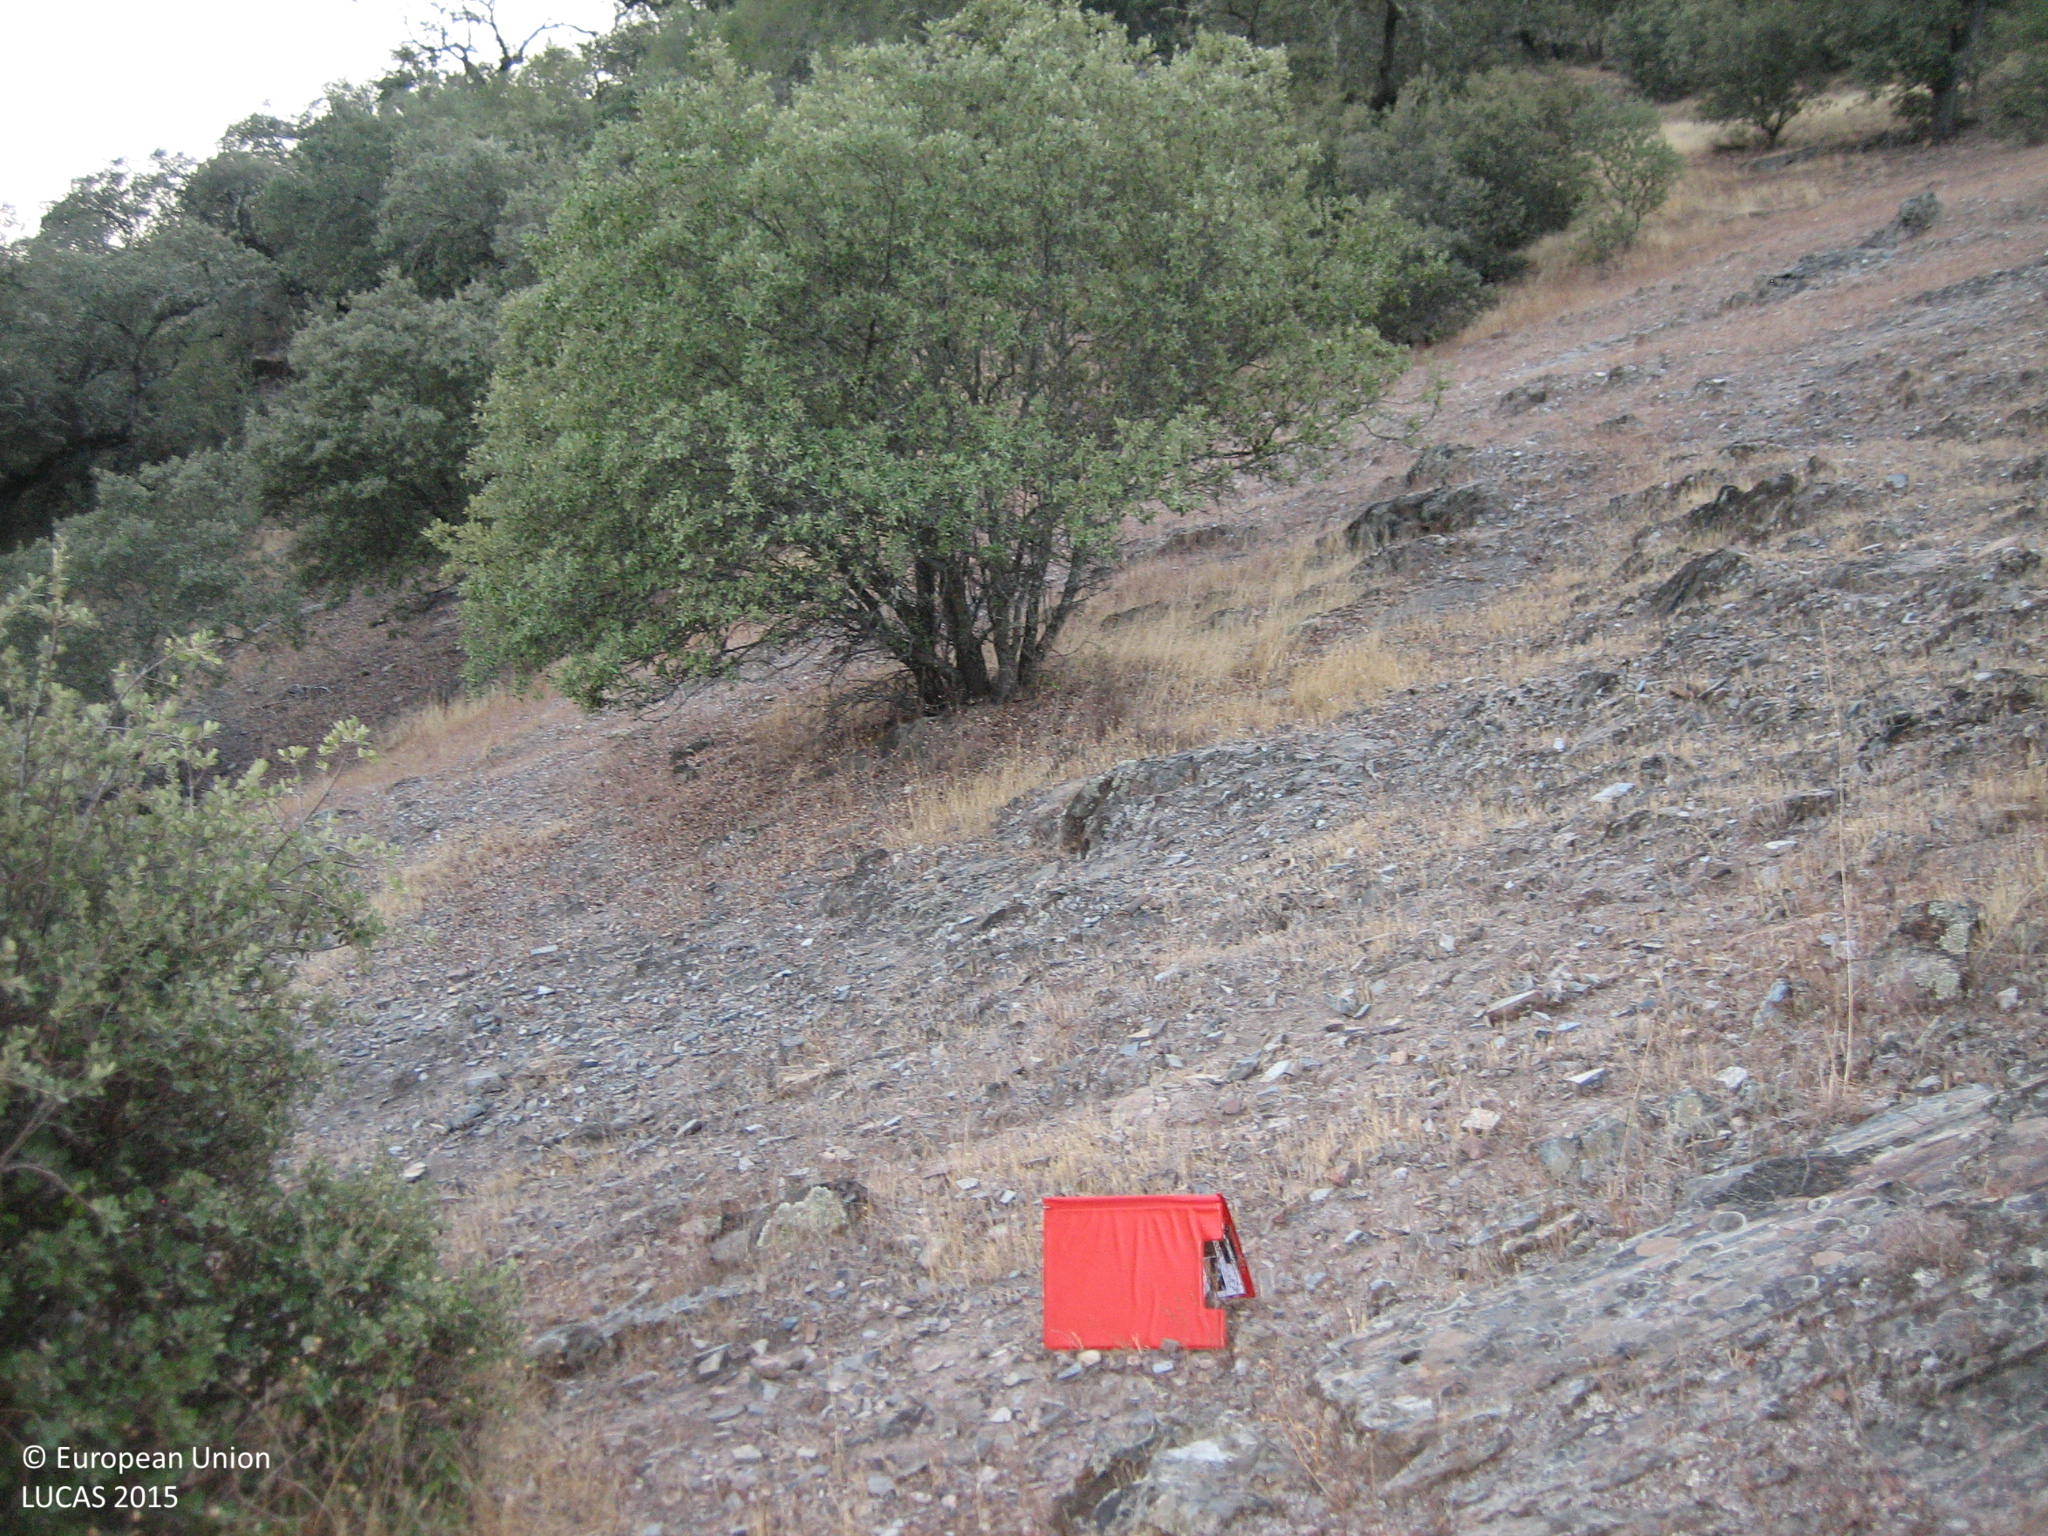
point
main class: Woodland
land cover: Broadleaved woodland
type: broadleaved evergreen forest
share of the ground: 10 - 25 %
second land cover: Shrubland without tree cover
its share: 10 - 25 %
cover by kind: herbaceous plants 40 %, broadleaved forest trees 20 %, shrubs 20 %, unconsolidated bare surface 20 %
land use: Forestry
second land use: Agriculture (excluding fallow land and kitchen gardens)
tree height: < 5 m
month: September
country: ES
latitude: 38.3610
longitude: -7.1271
